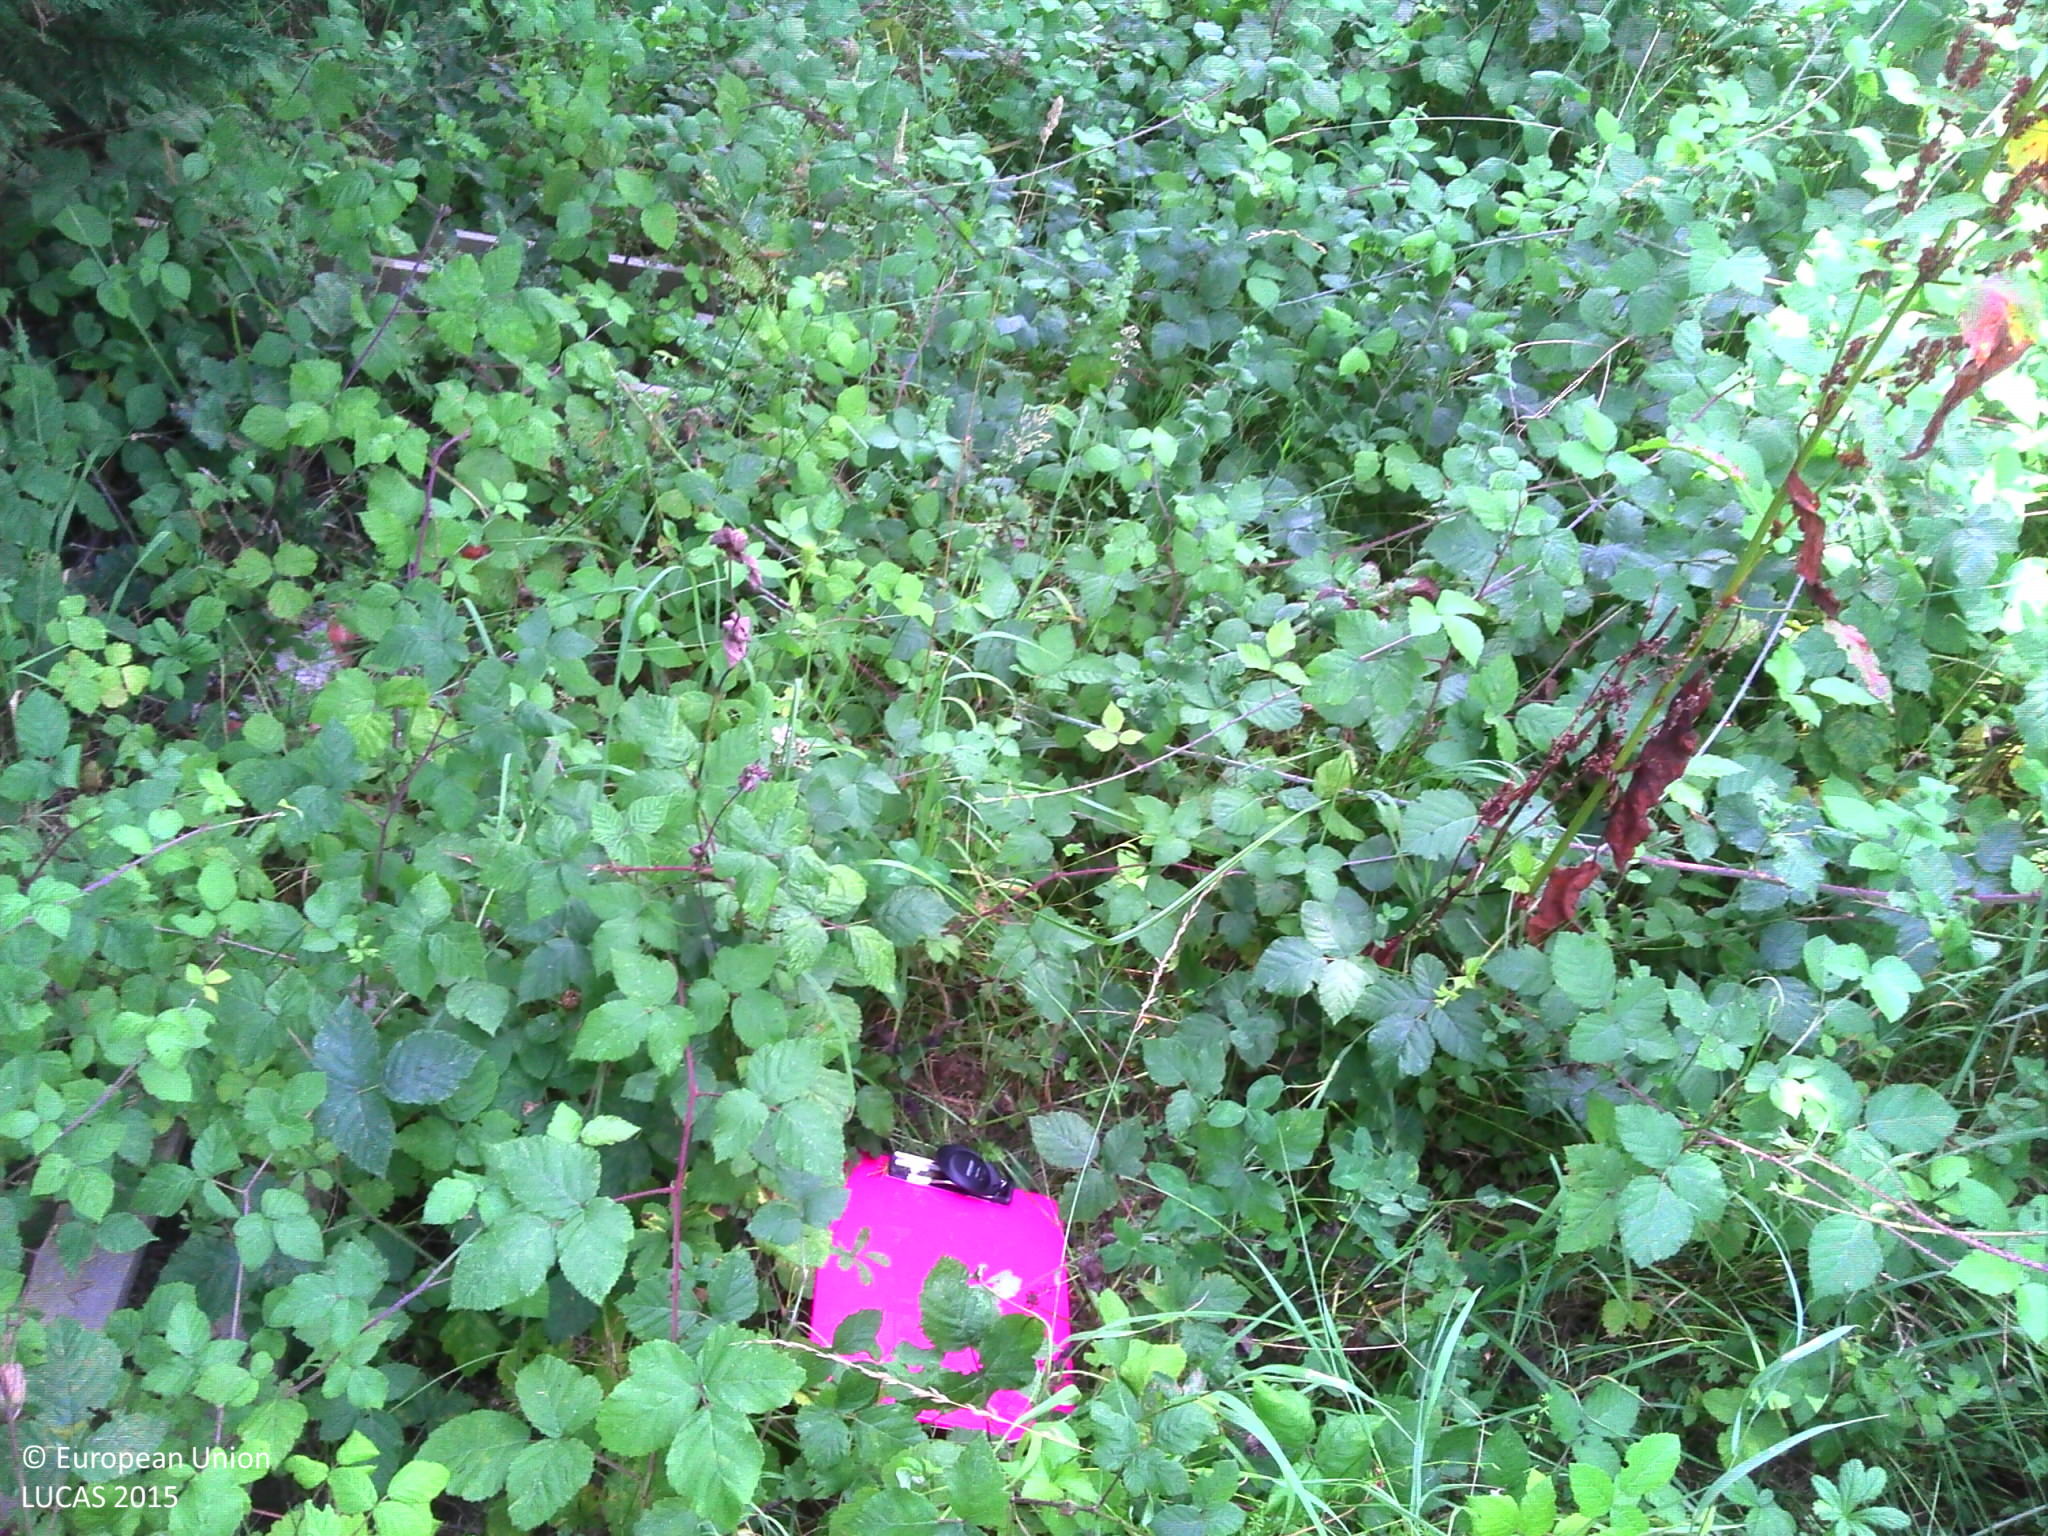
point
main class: Grassland
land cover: Spontaneously vegetated surfaces
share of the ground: > 75 %
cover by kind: herbaceous plants 95 %, shrubs 5 %
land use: Semi-natural and natural areas not in use
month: July
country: FR
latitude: 43.1436
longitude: 1.4353
